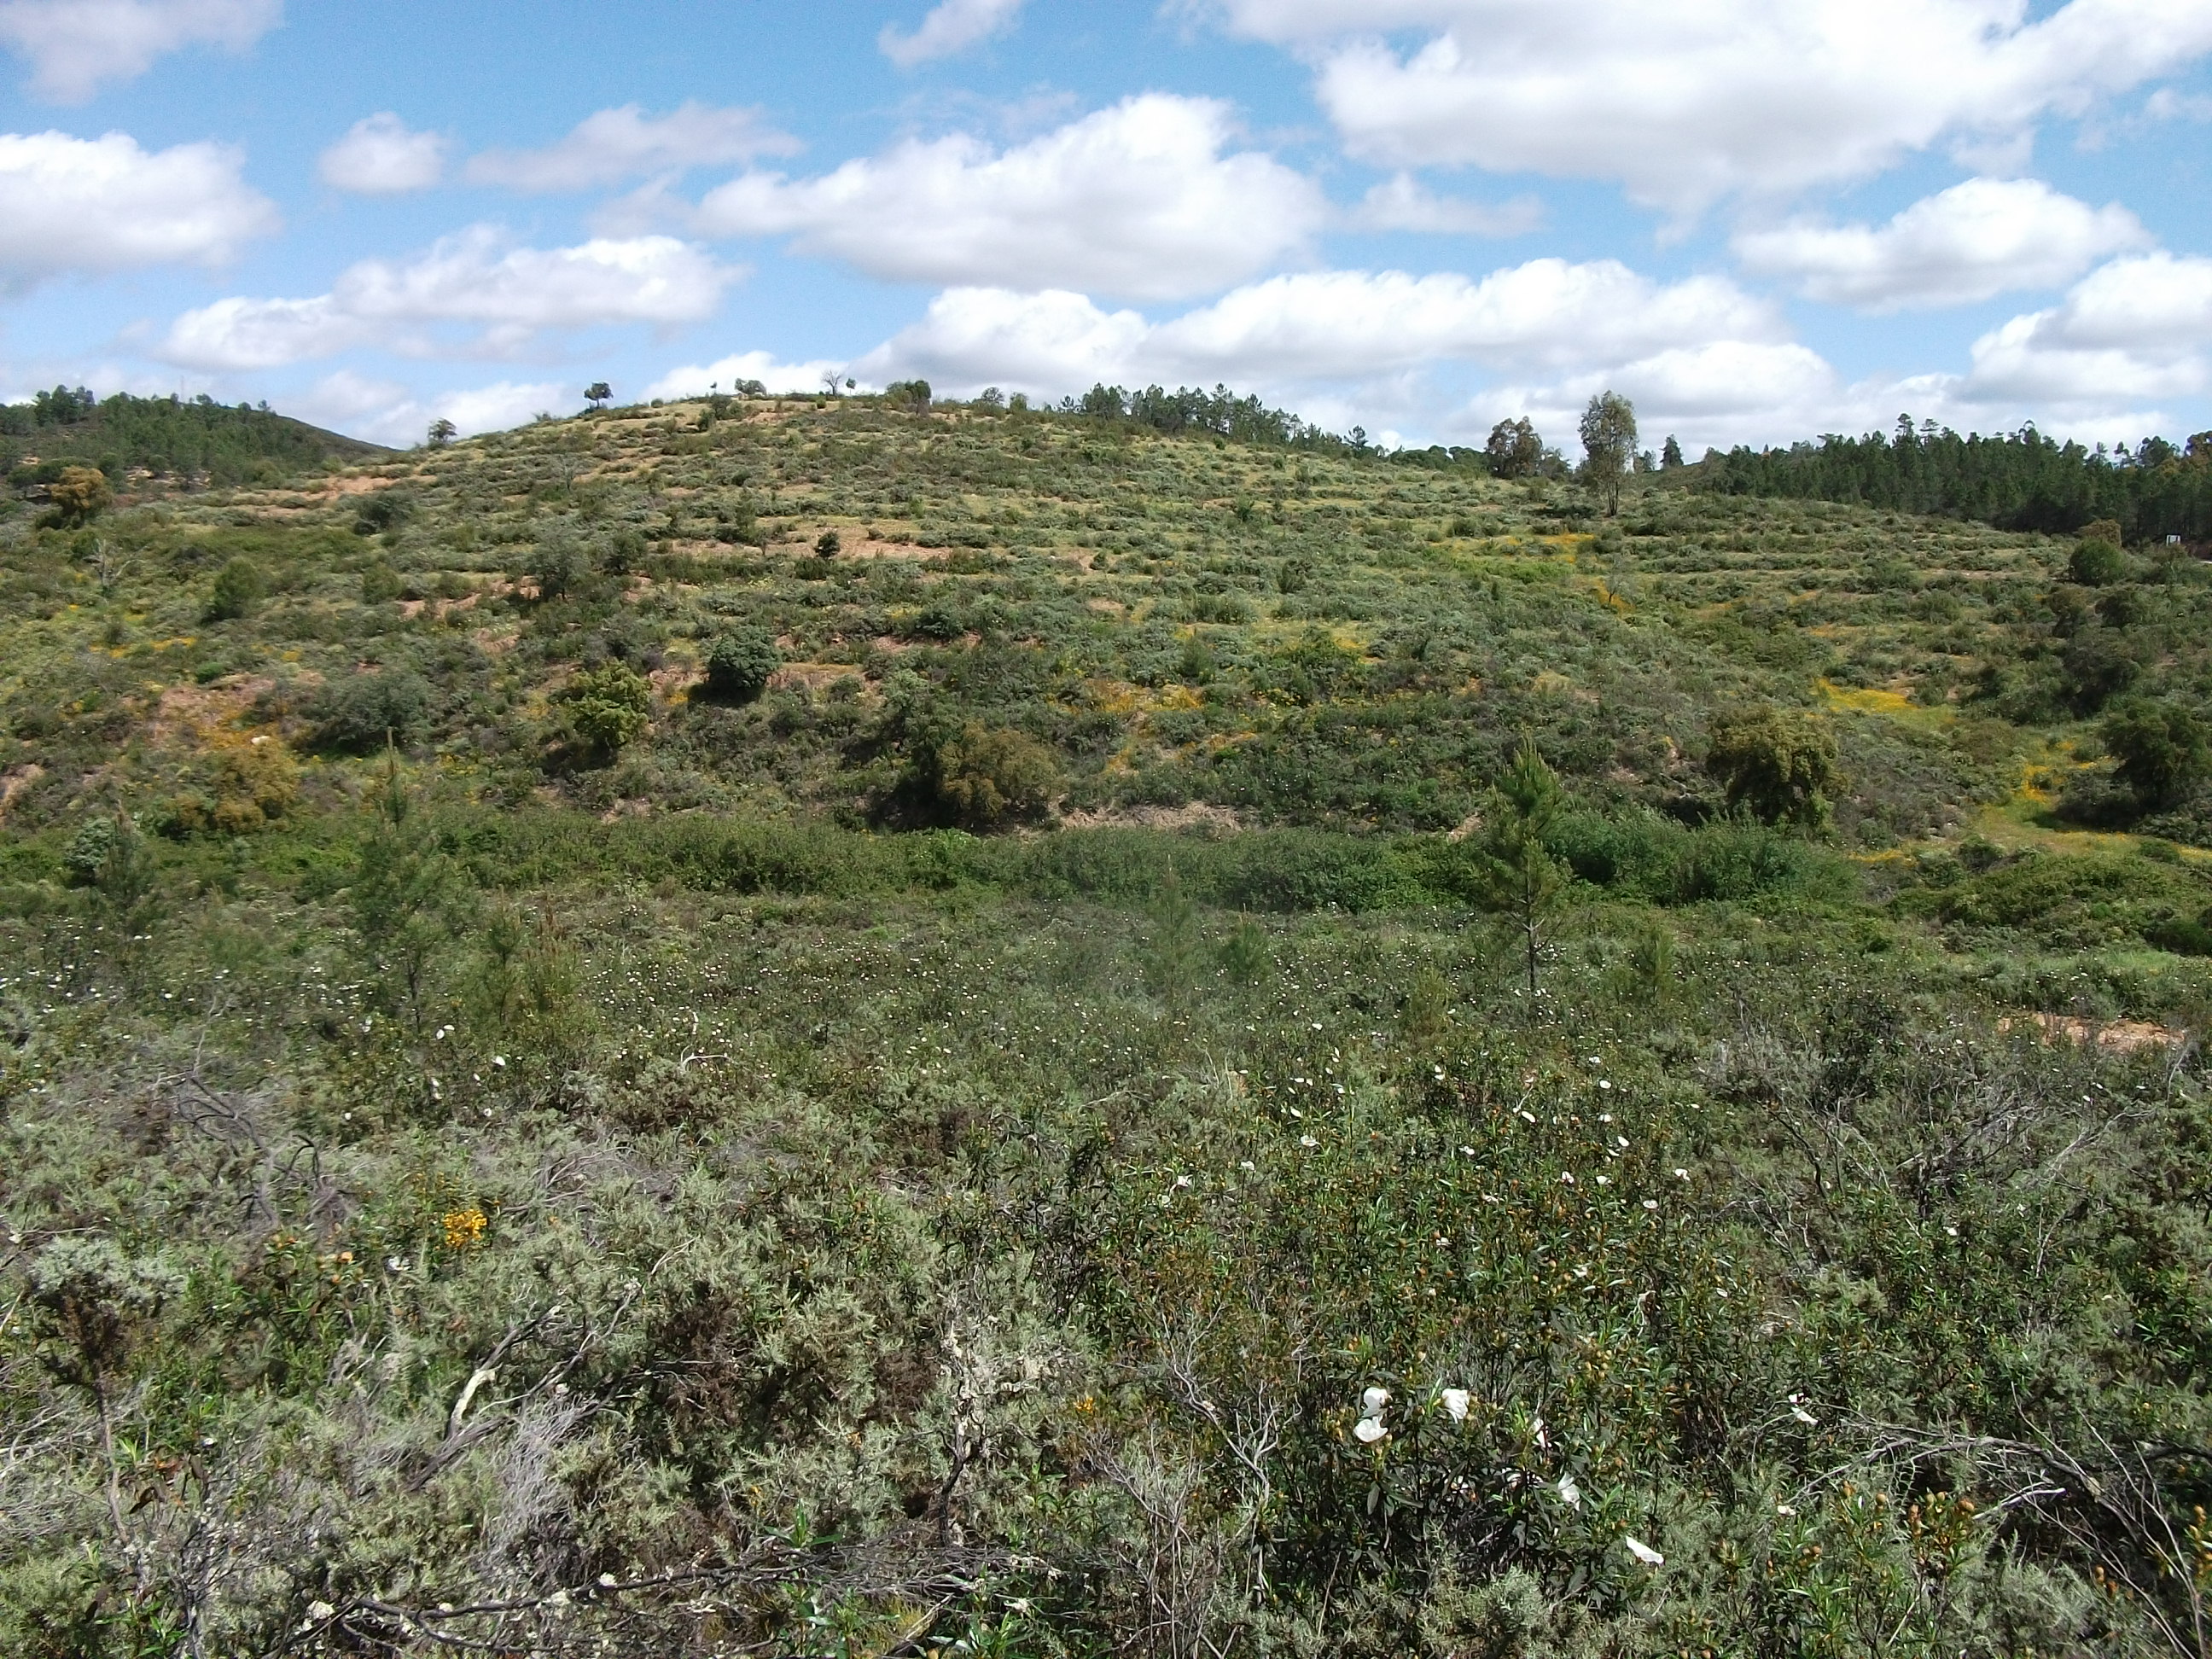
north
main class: Shrubland
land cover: Shrubland with sparse tree cover
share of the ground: > 75 %
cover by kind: shrubs 95 %, coniferous forest trees 5 %
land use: Abandoned areas
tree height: < 5 m
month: May
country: ES
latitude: 37.6891
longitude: -6.6546
